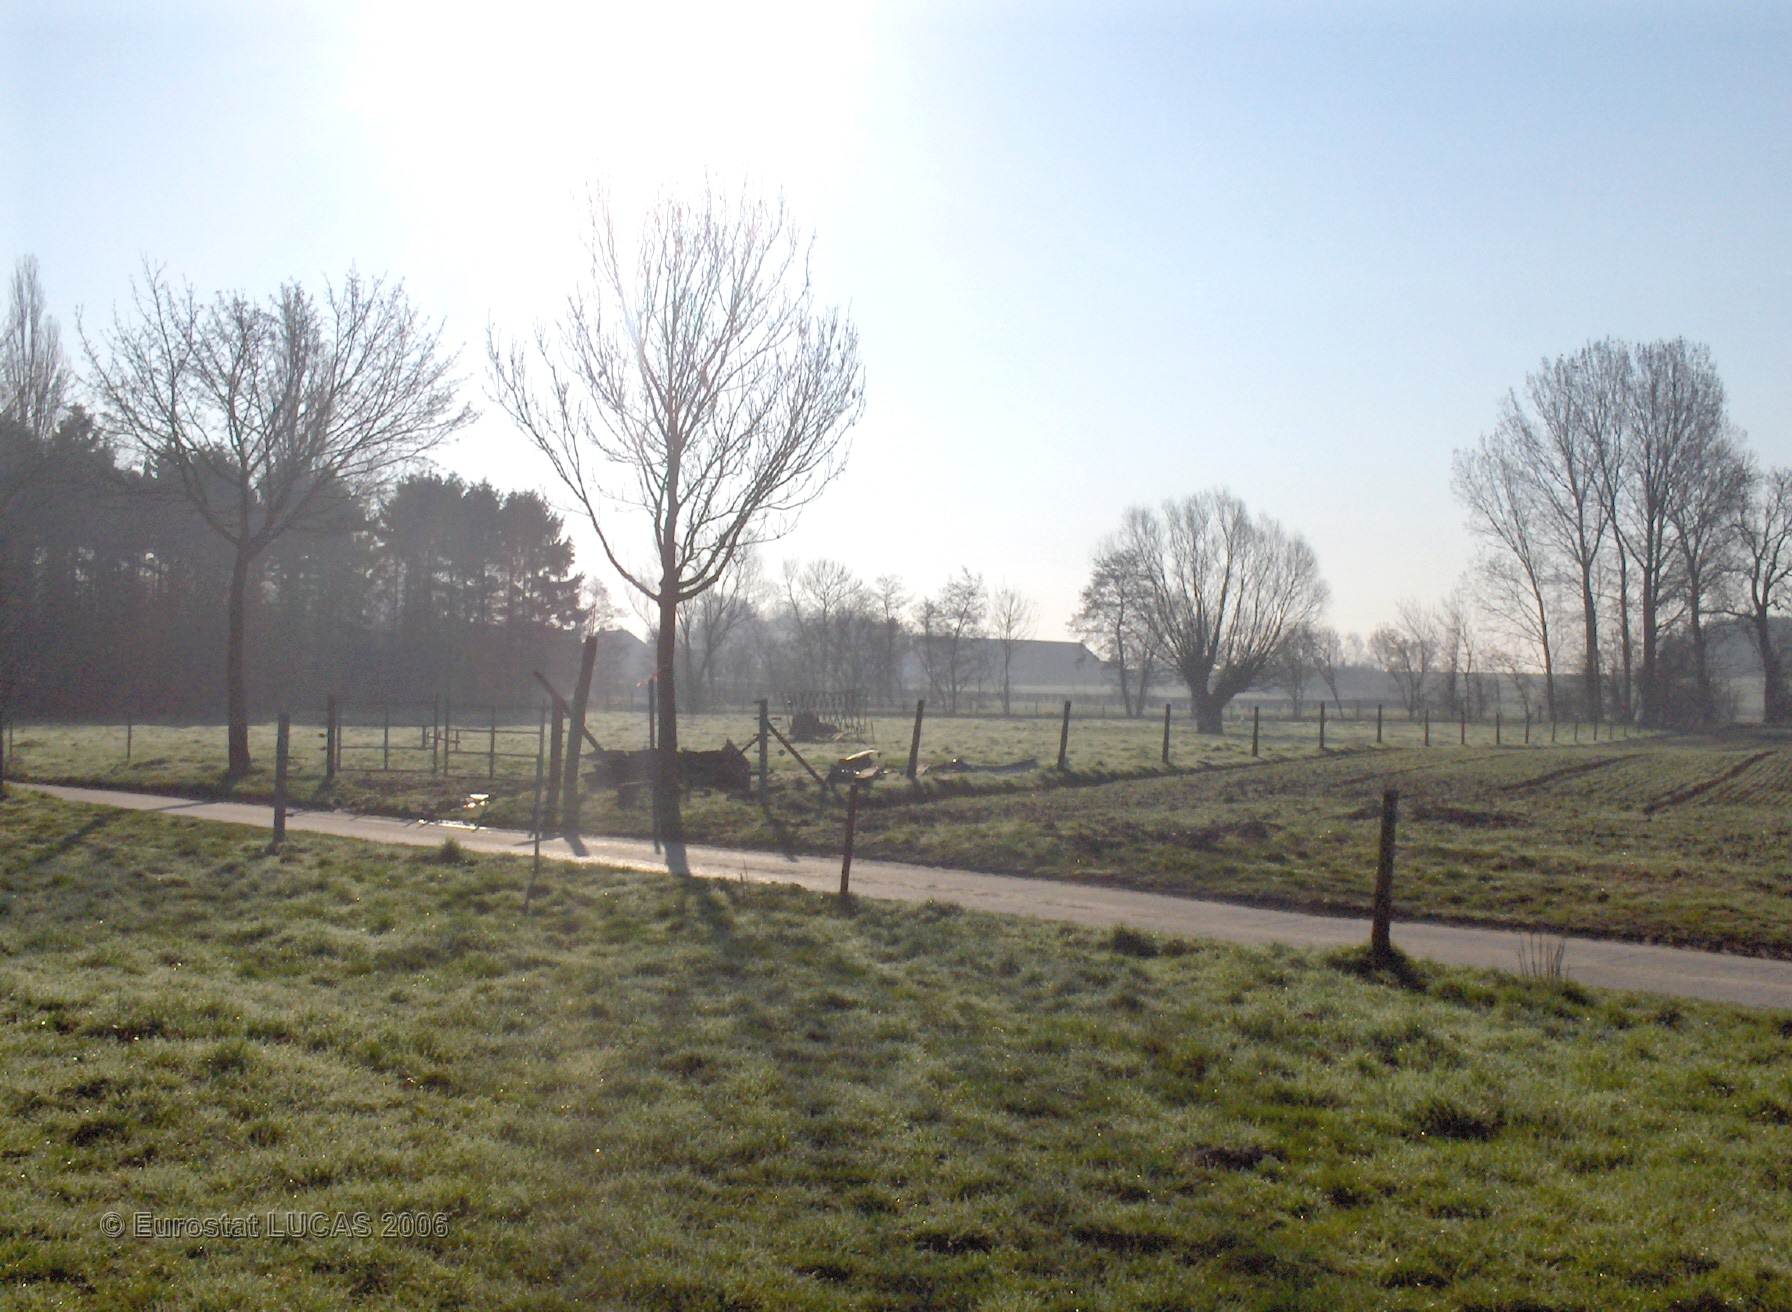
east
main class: Grassland
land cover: Grassland without tree/shrub cover
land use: Agriculture (excluding fallow land and kitchen gardens)
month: April
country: BE
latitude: 50.5013
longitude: 4.4832
